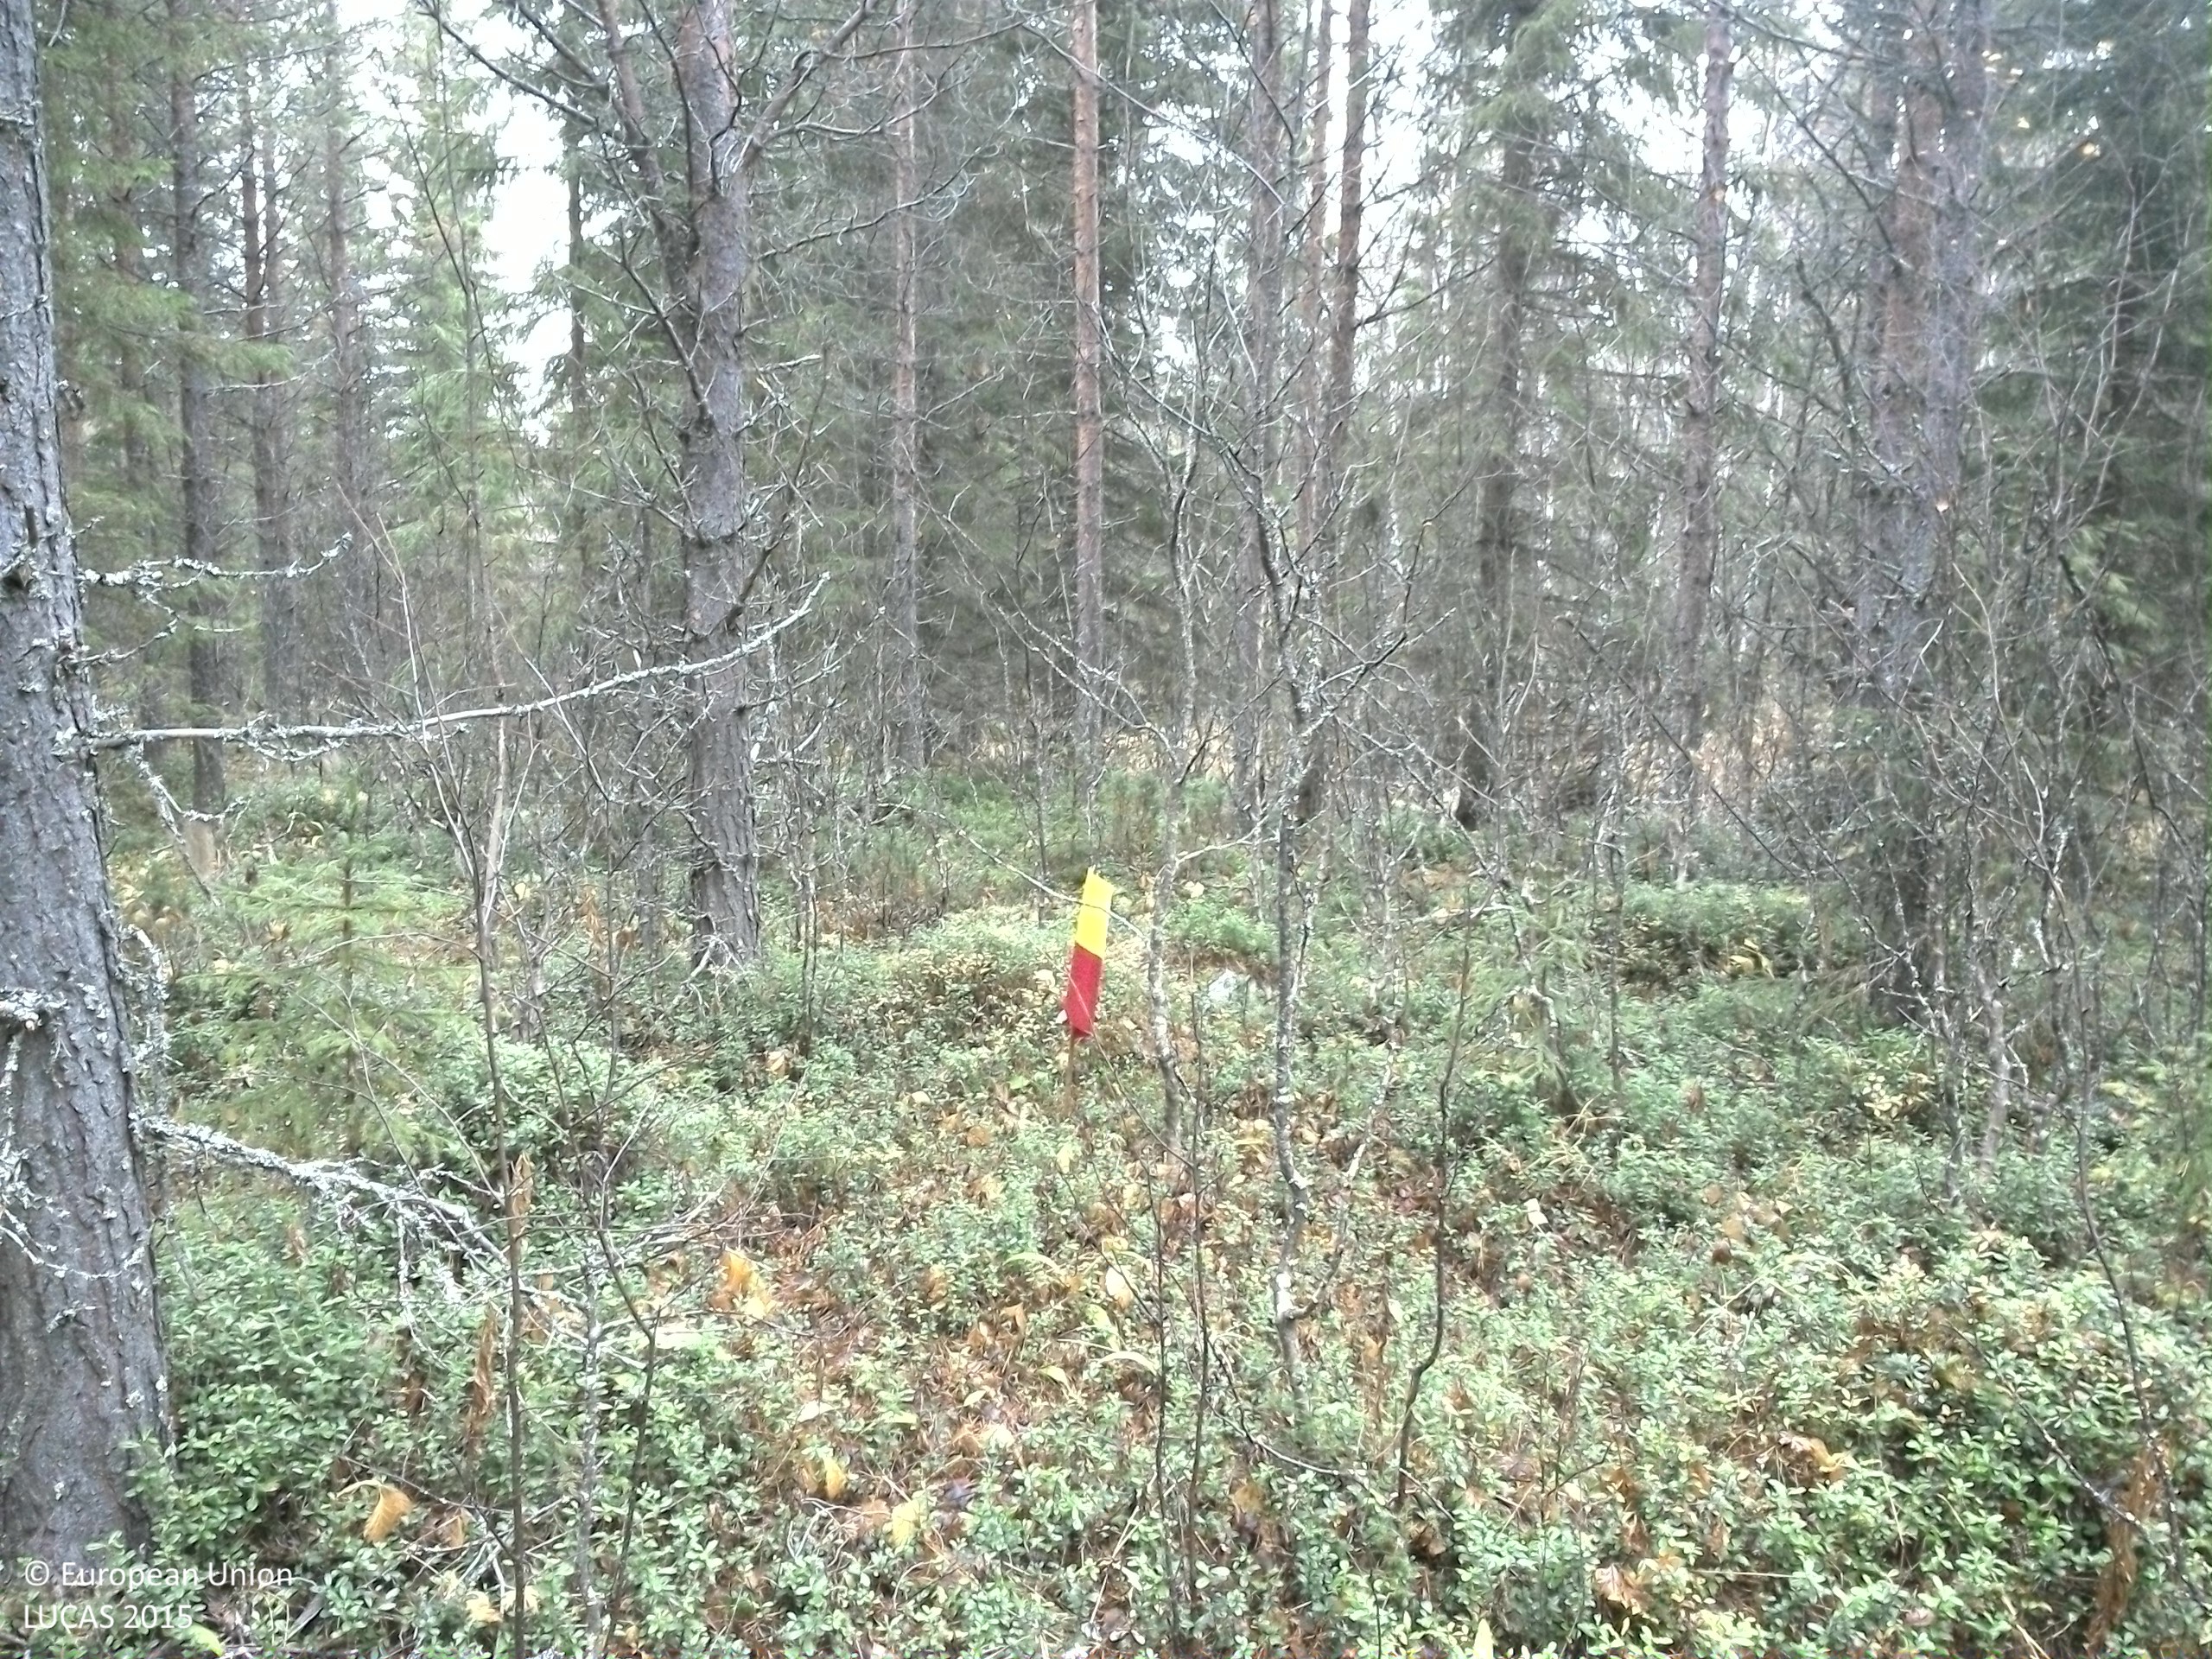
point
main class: Woodland
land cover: Other mixed woodland
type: boreal forest
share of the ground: 50 - 75 %
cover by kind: coniferous forest trees 45 %, shrubs 25 %, broadleaved forest trees 15 %, lichens and mosses 10 %, herbaceous plants 5 %
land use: Forestry
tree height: > 5 m
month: October
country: SE
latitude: 64.2893
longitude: 15.3638
